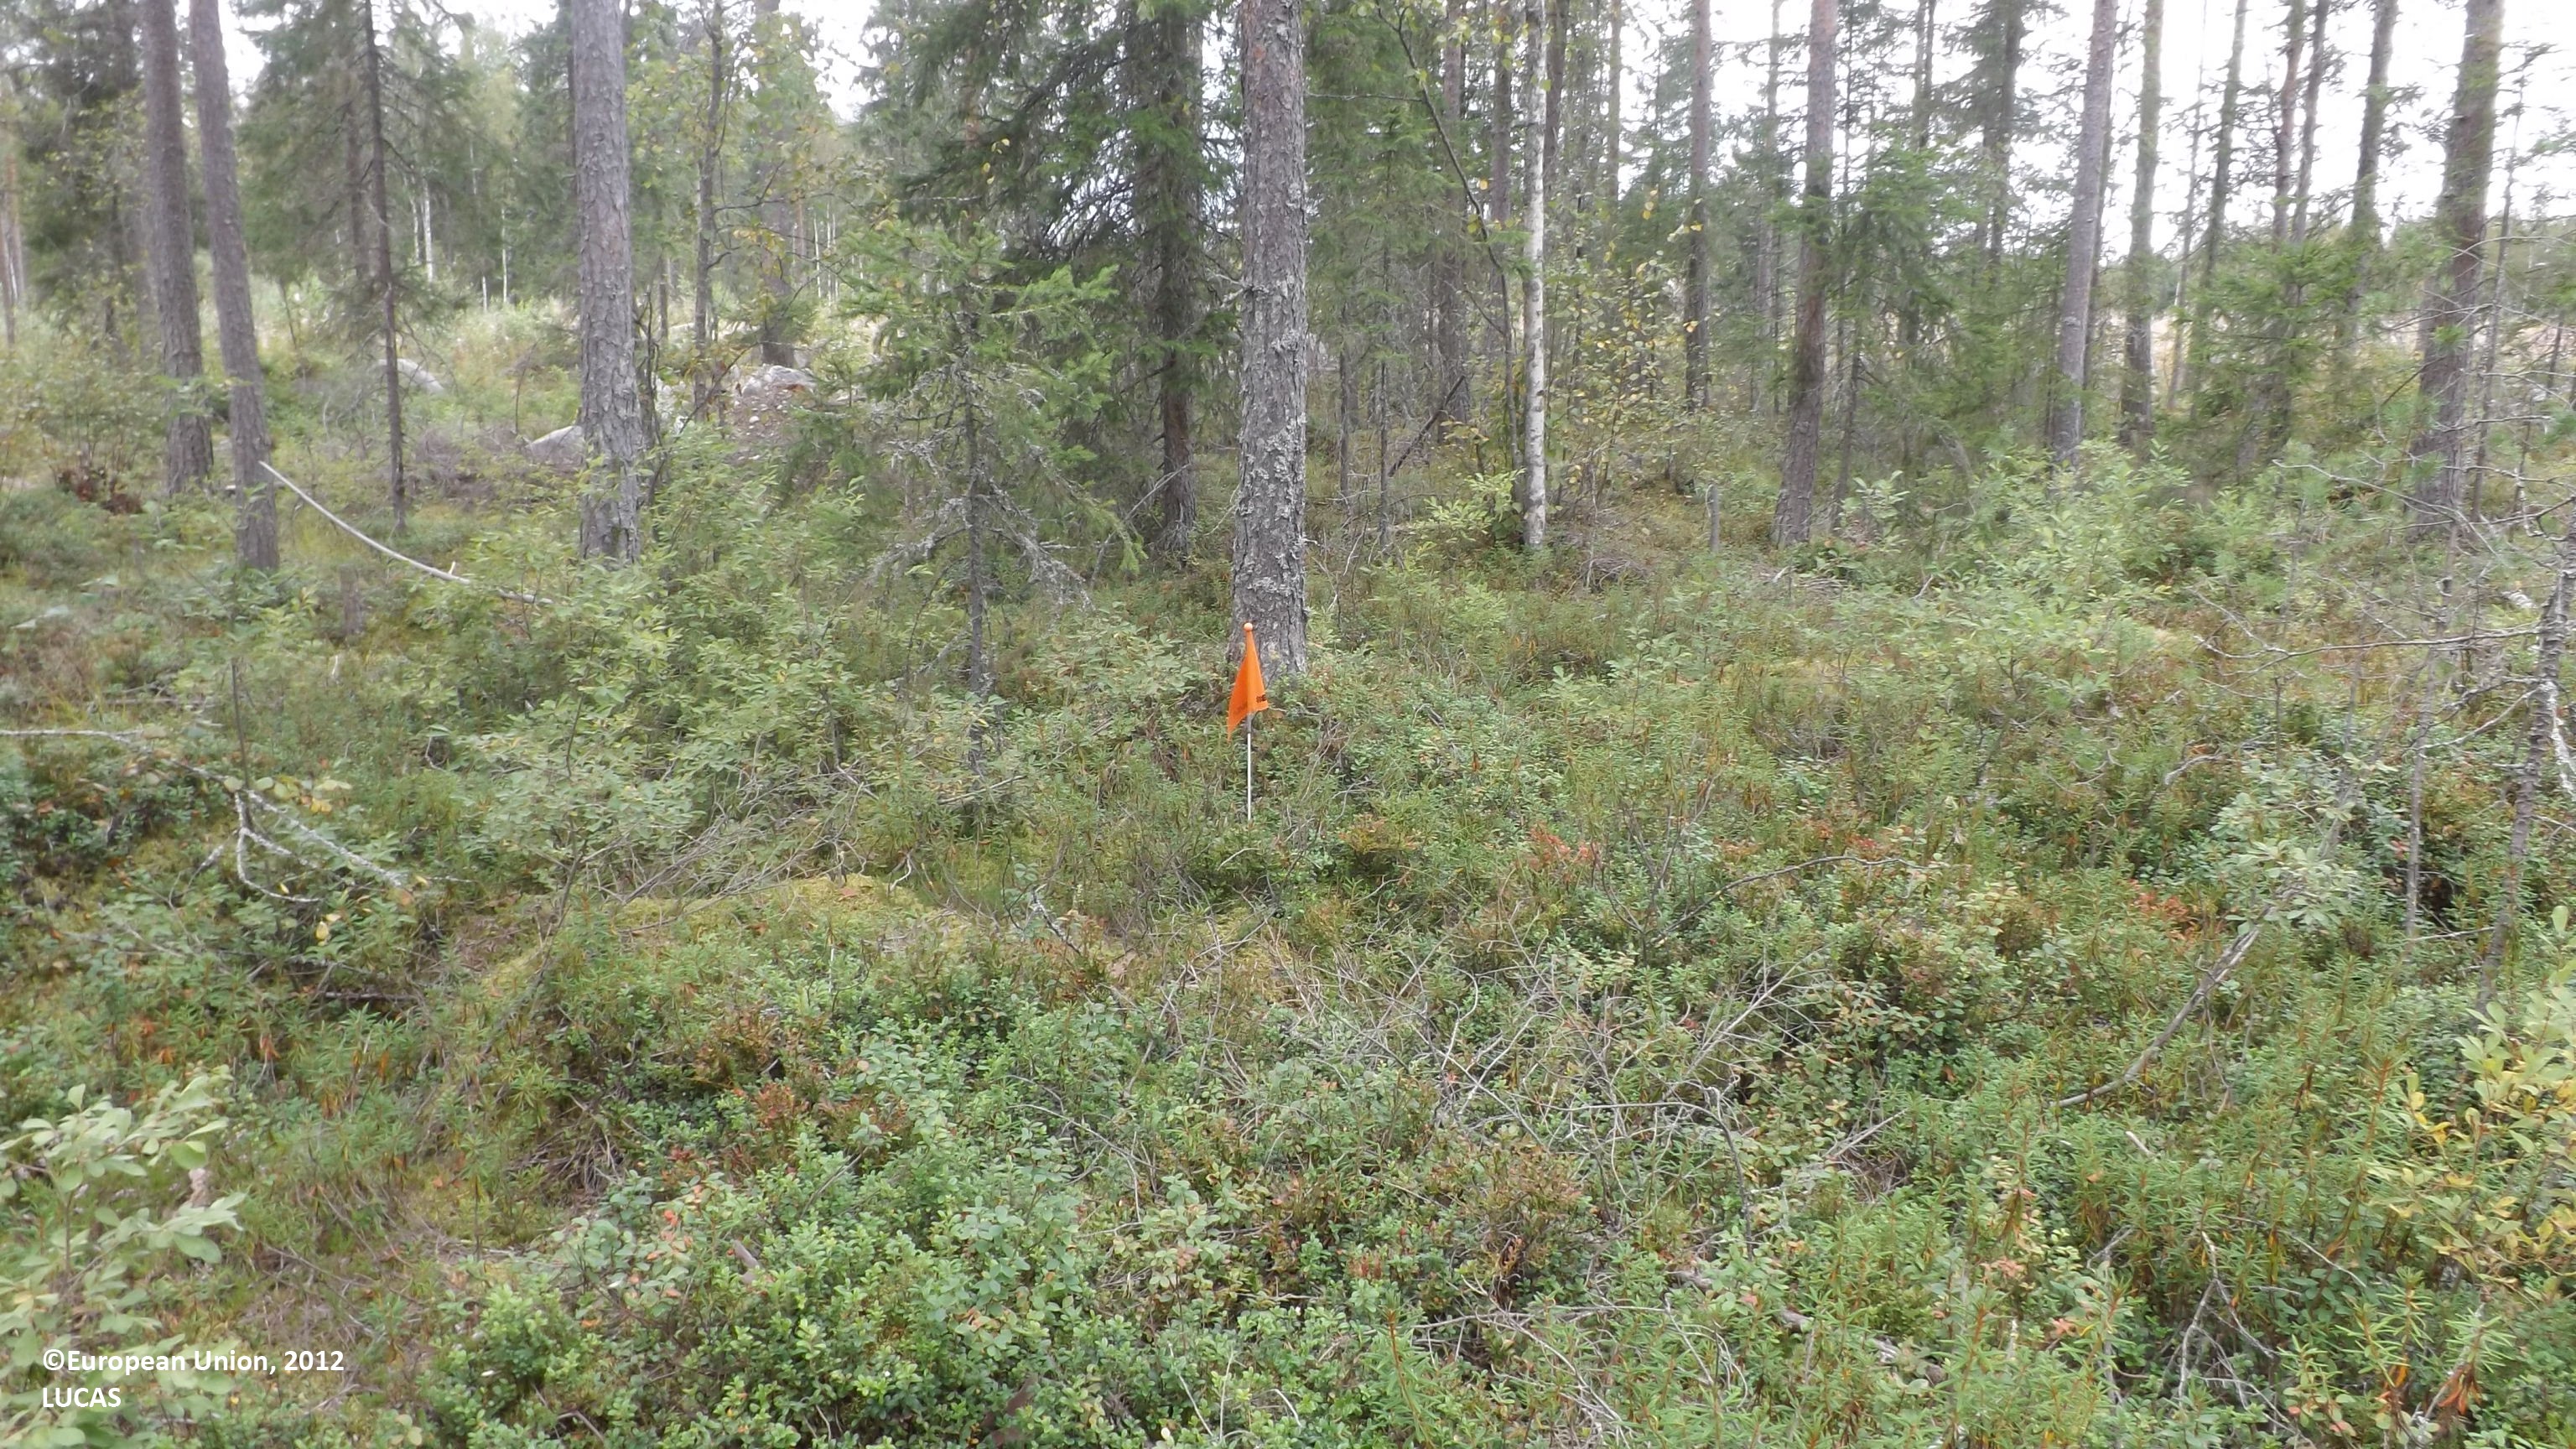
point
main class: Woodland
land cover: Other mixed woodland
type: boreal forest
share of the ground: 25 - 50 %
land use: Forestry
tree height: > 5 m
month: August
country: FI
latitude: 63.9639
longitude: 23.9294
